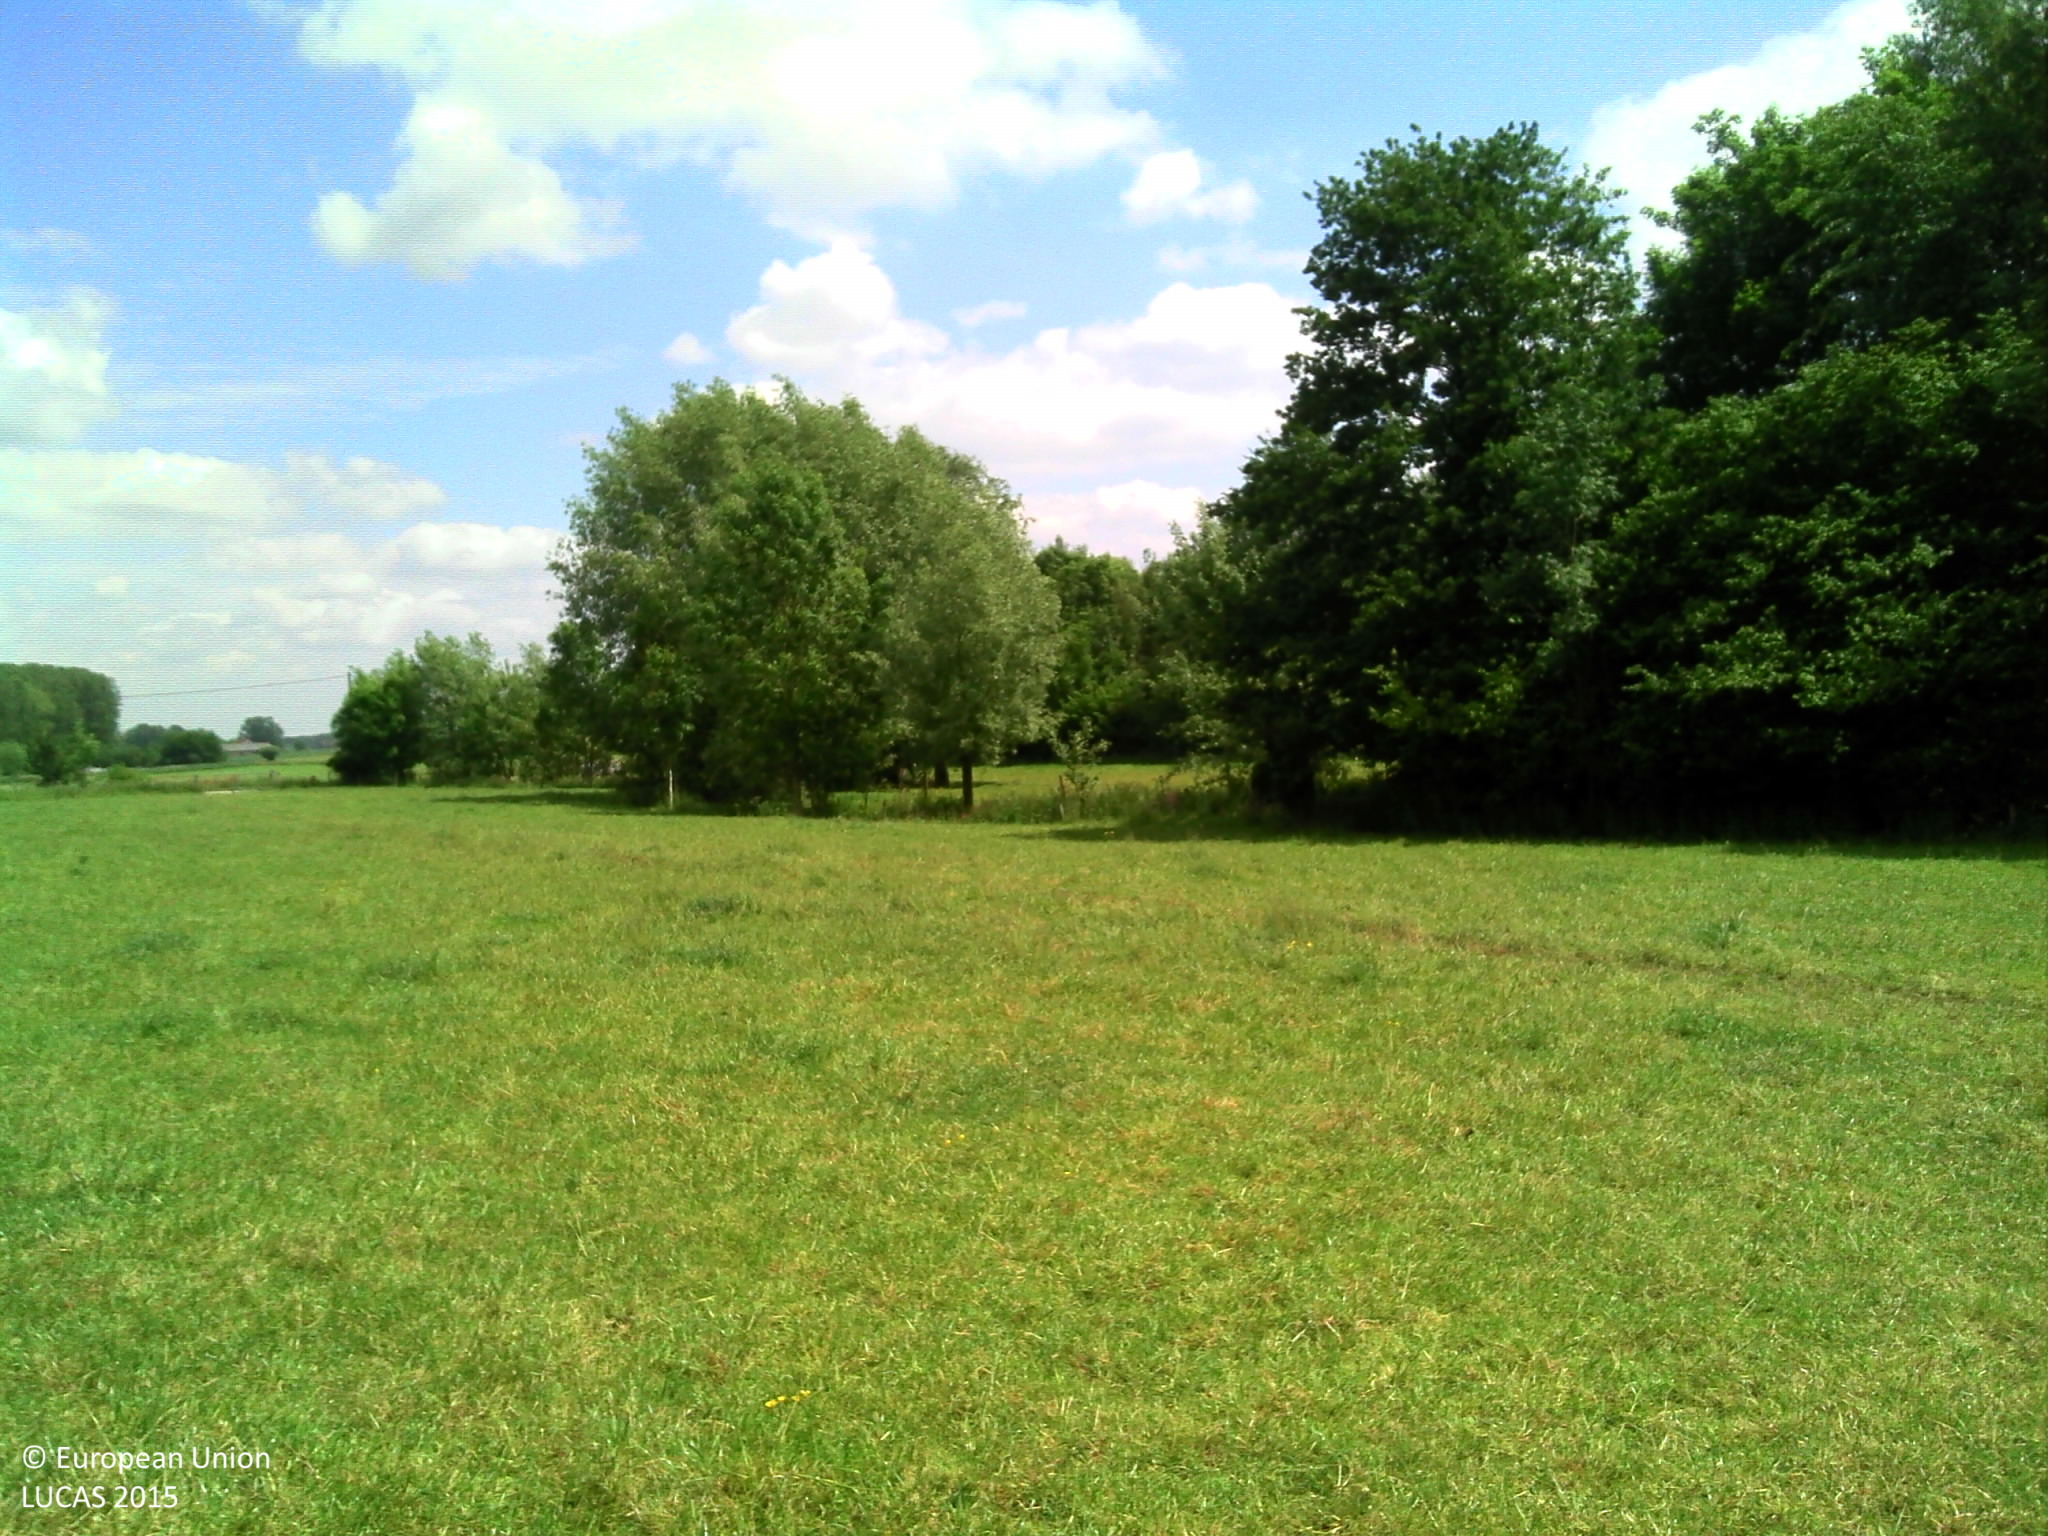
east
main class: Grassland
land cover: Grassland without tree/shrub cover
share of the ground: > 75 %
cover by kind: herbaceous plants 100 %
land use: Agriculture (excluding fallow land and kitchen gardens)
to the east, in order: Grassland without tree/shrub cover; Fences; Ditches and canals; Fences; Grassland without tree/shrub cover; Fences; Grass margins; Paved roads, cycling and walking lanes; Grass margins; Ditches and canals; Electric lines; Fences; Grassland without tree/shrub cover
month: June
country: BE
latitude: 50.7907
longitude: 3.7942
